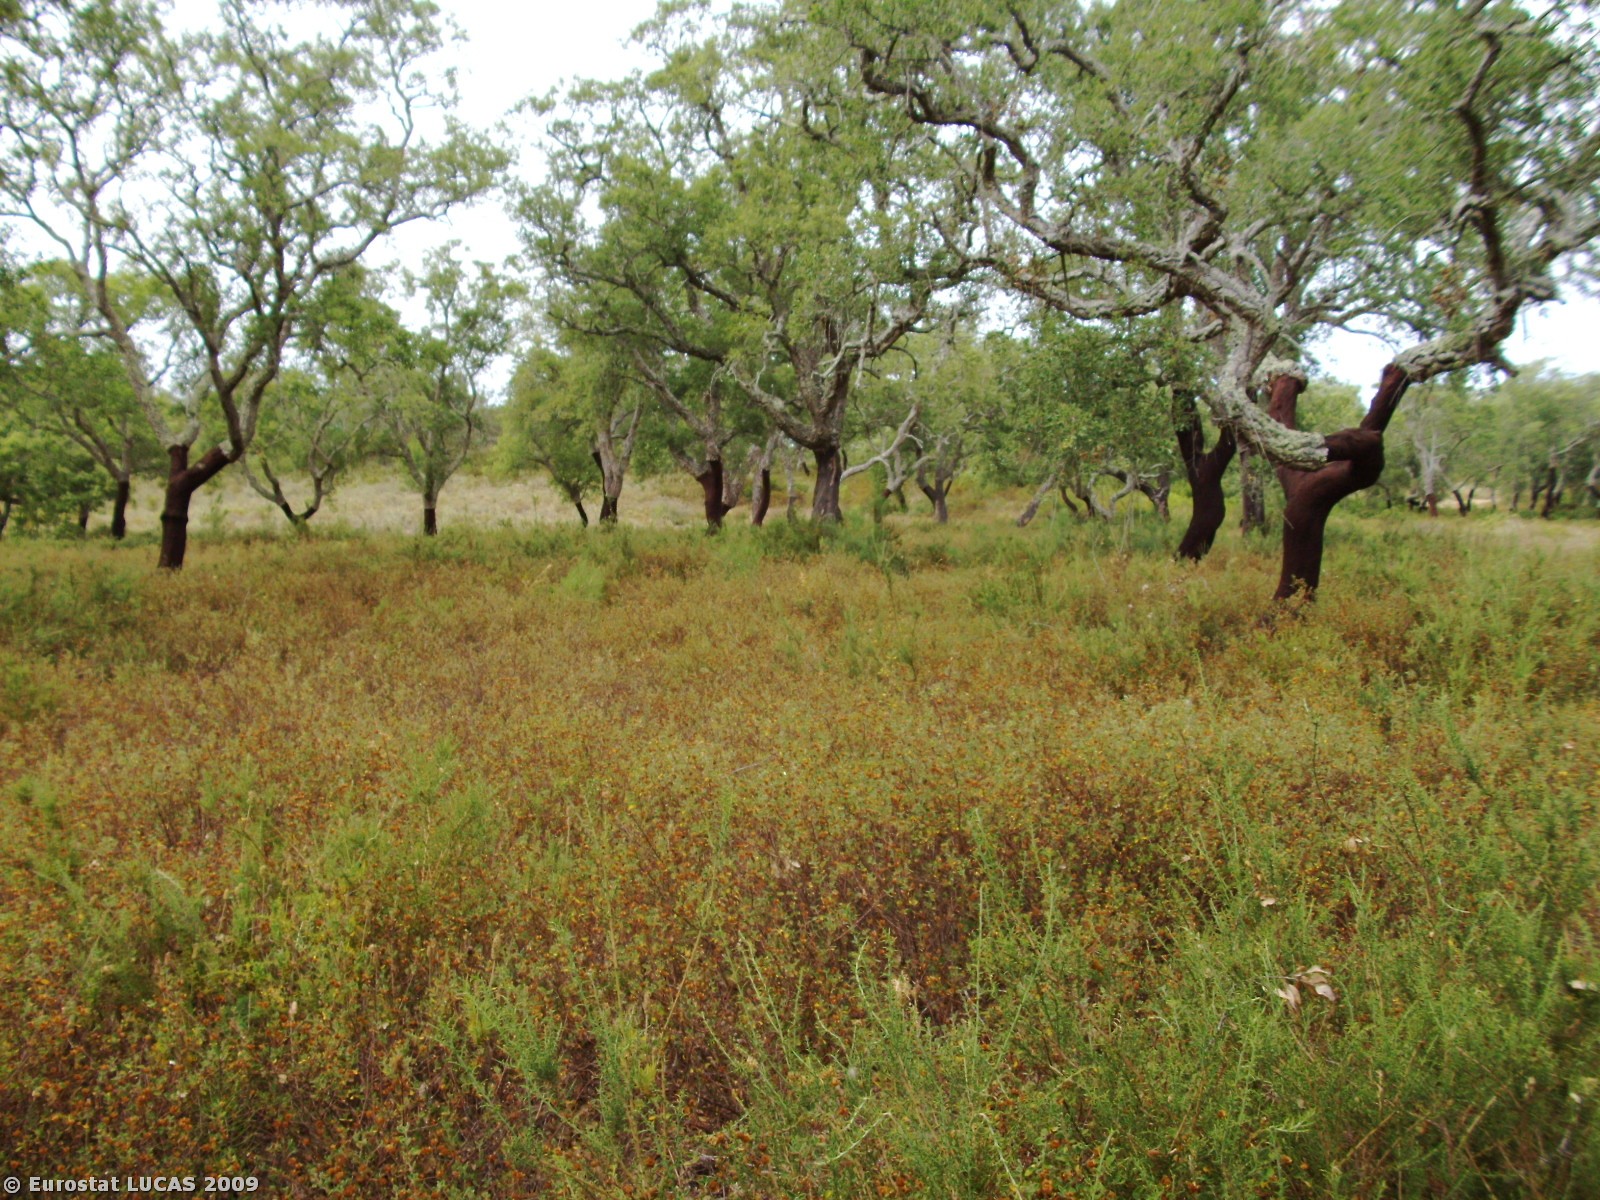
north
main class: Woodland
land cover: Broadleaved woodland
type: broadleaved evergreen forest
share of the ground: 10 - 25 %
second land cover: Shrubland with sparse tree cover
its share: 50 - 75 %
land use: Forestry
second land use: Unused
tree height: > 5 m
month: June
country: PT
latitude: 38.0564
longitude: -8.7293
